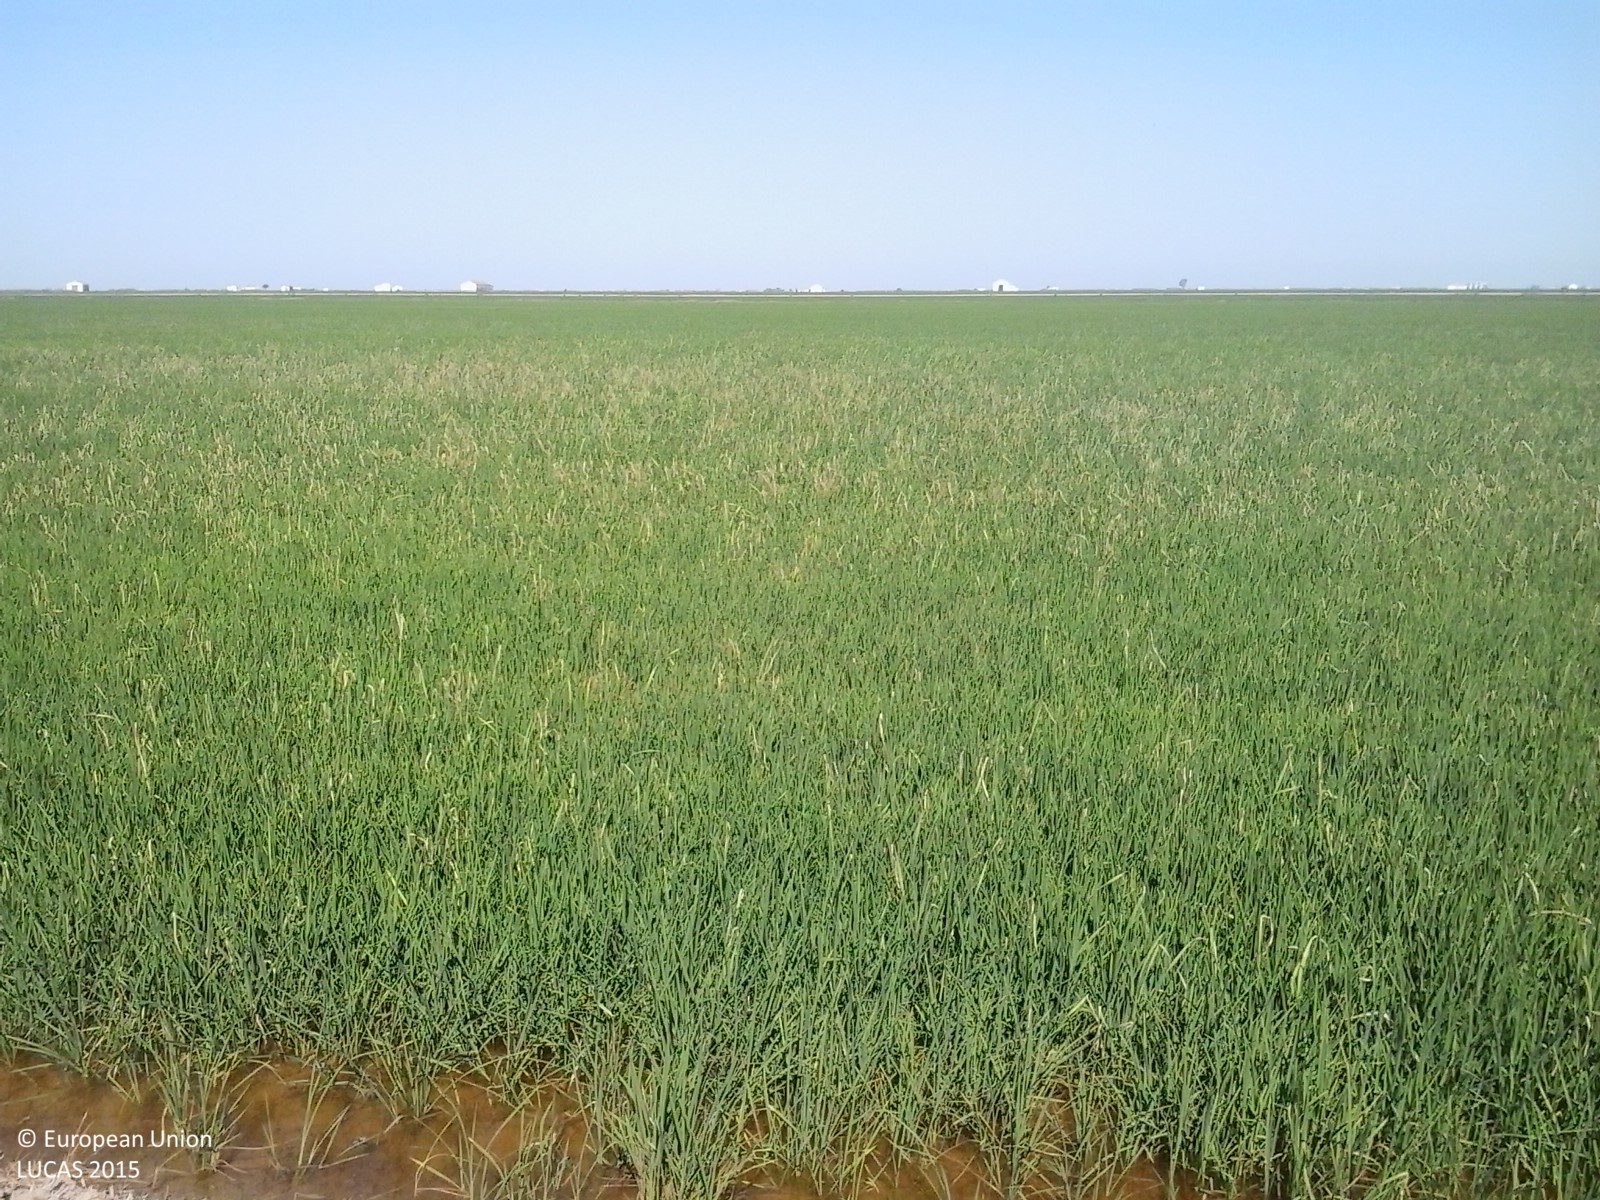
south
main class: Cropland
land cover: Rice
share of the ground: > 75 %
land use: Agriculture (excluding fallow land and kitchen gardens)
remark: Temporary flooded
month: July
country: ES
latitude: 37.0684
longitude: -6.0912
